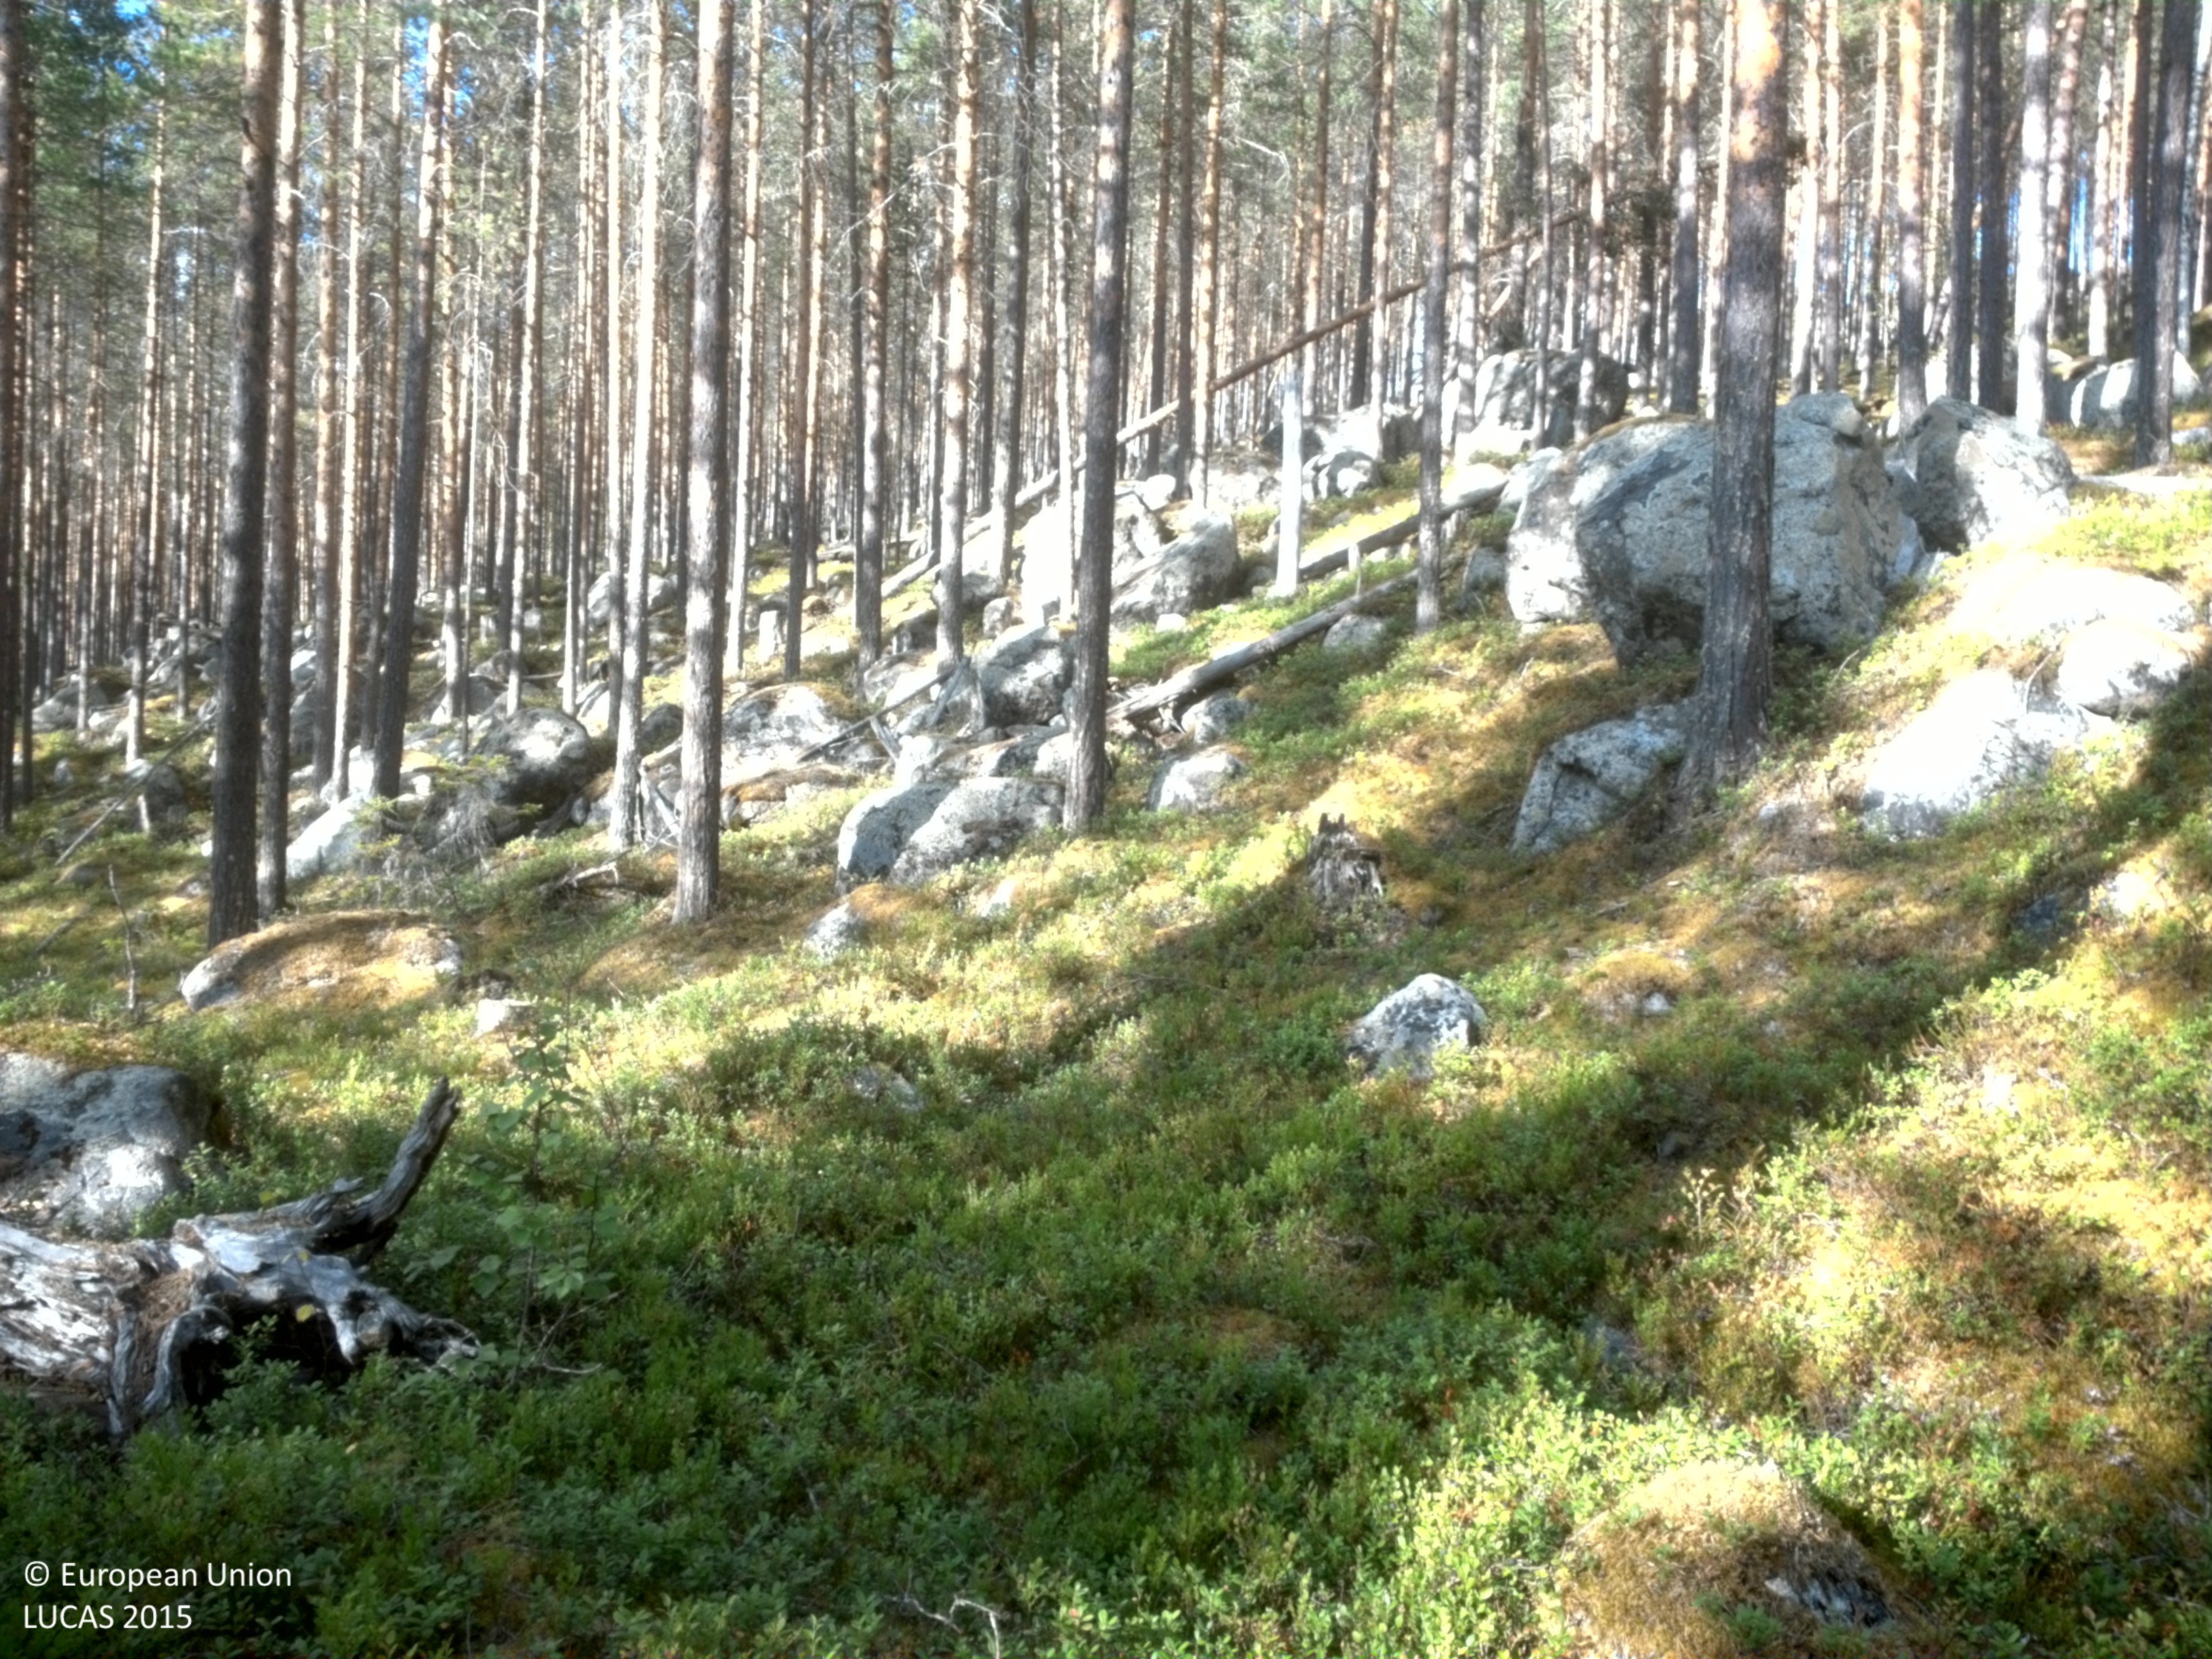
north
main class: Woodland
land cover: Pine dominated coniferous woodland
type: boreal forest
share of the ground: 50 - 75 %
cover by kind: coniferous forest trees 55 %, shrubs 30 %, lichens and mosses 15 %
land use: Forestry
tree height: > 5 m
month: September
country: SE
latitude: 64.4107
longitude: 19.0803
